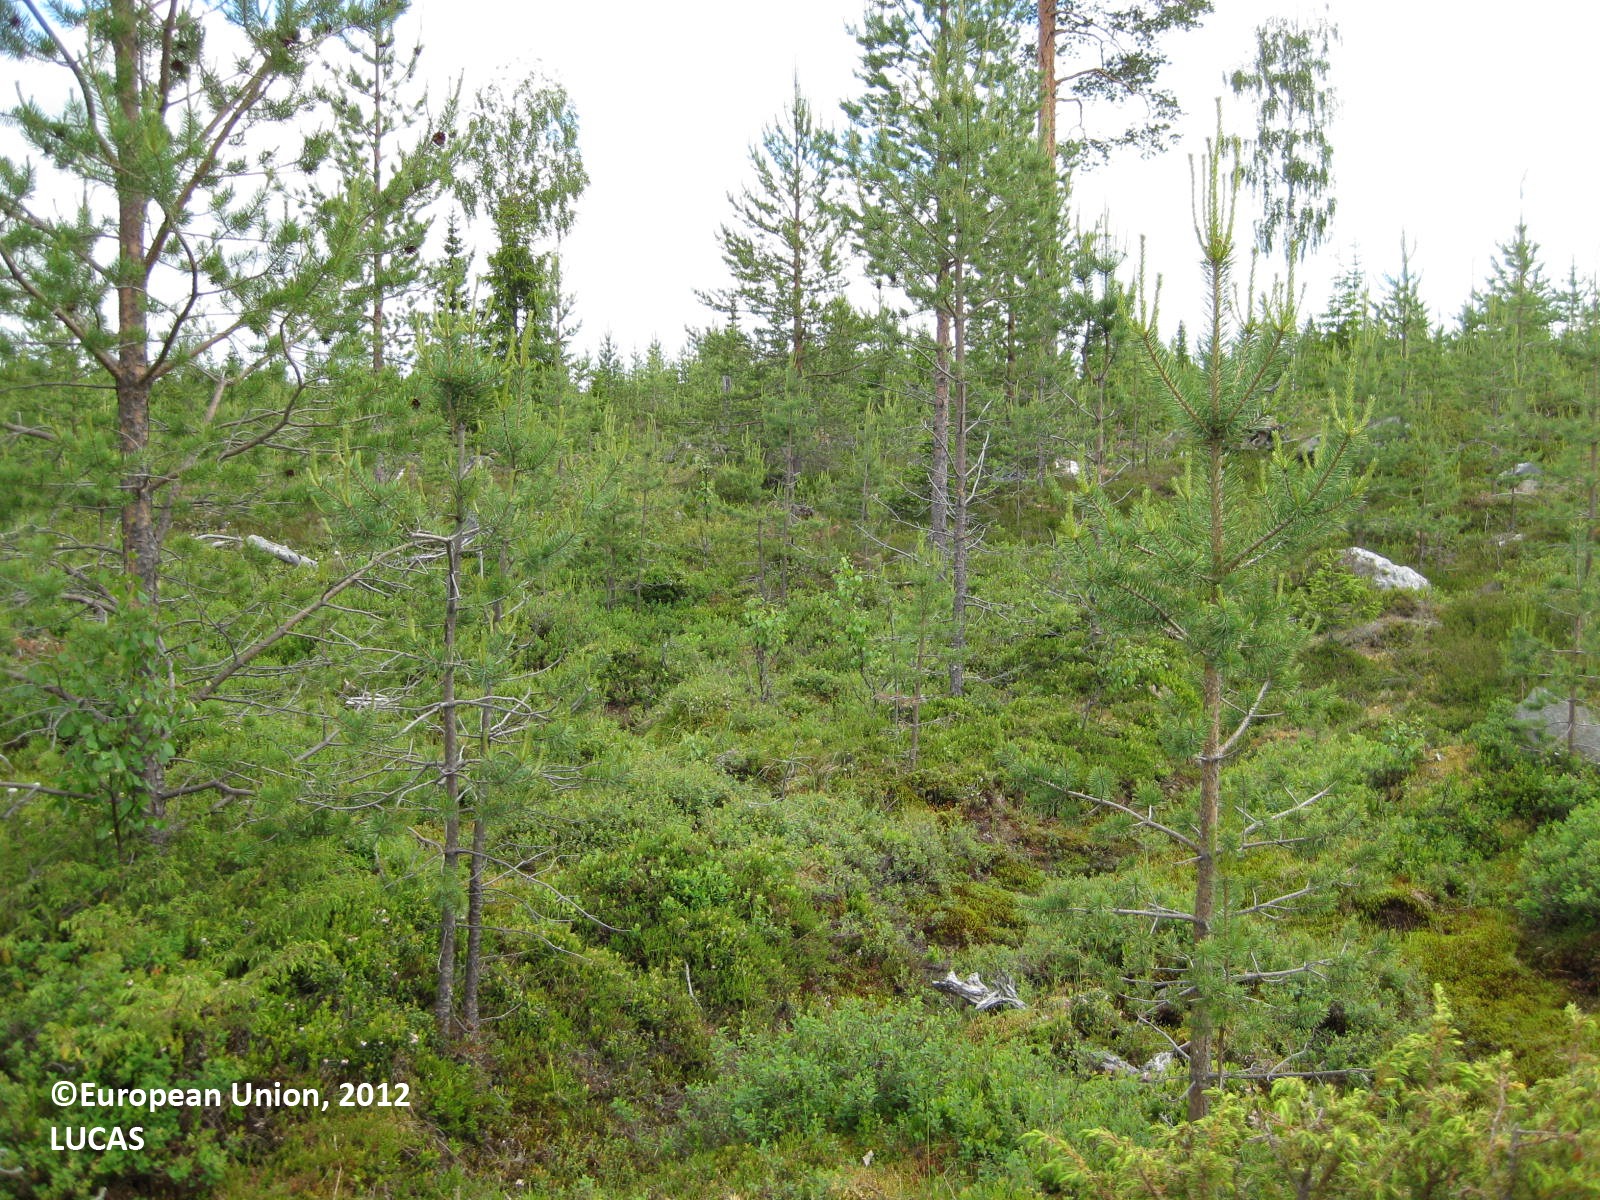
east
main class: Woodland
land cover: Pine dominated coniferous woodland
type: boreal forest
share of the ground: 50 - 75 %
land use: Forestry
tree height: > 5 m
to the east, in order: Pine dominated coniferous woodland; Tracks; Abandoned hedges; Tracks; Pine dominated coniferous woodland; Paved roads, cycling and walking lanes; Other coniferous woodland; Pine dominated coniferous woodland
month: July
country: FI
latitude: 65.4805
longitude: 29.3027
